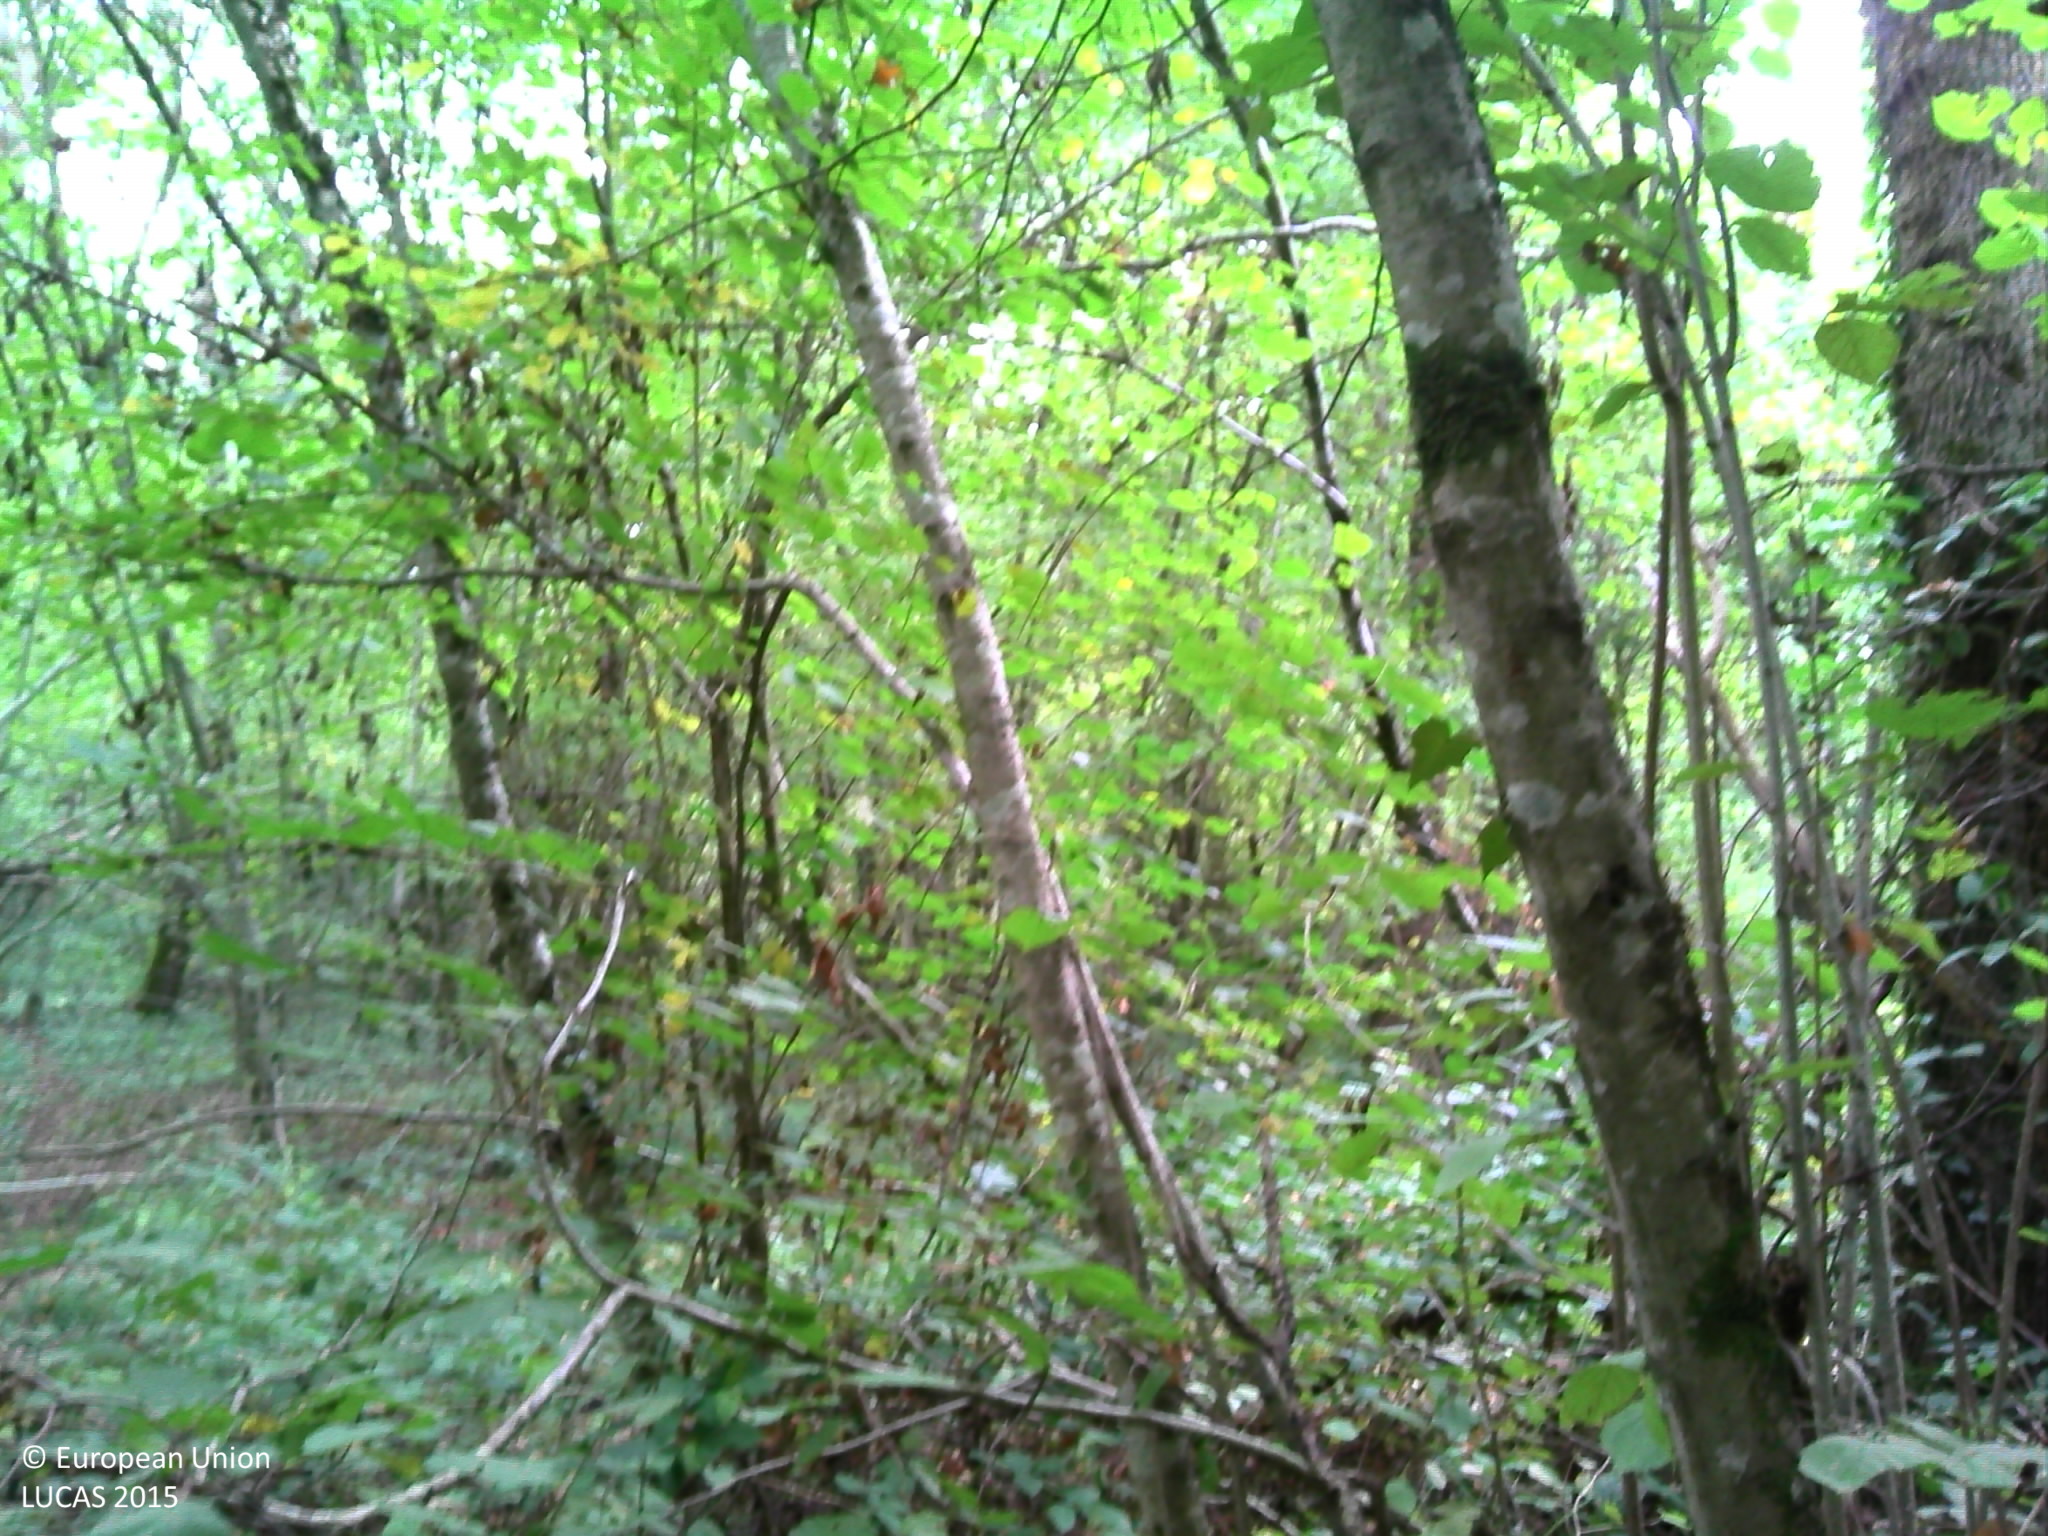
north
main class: Woodland
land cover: Broadleaved woodland
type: mesophytic deciduous forest
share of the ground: > 75 %
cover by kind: broadleaved forest trees 90 %, herbaceous plants 10 %
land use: Forestry
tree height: > 5 m
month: October
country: FR
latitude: 46.2755
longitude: 5.1104
